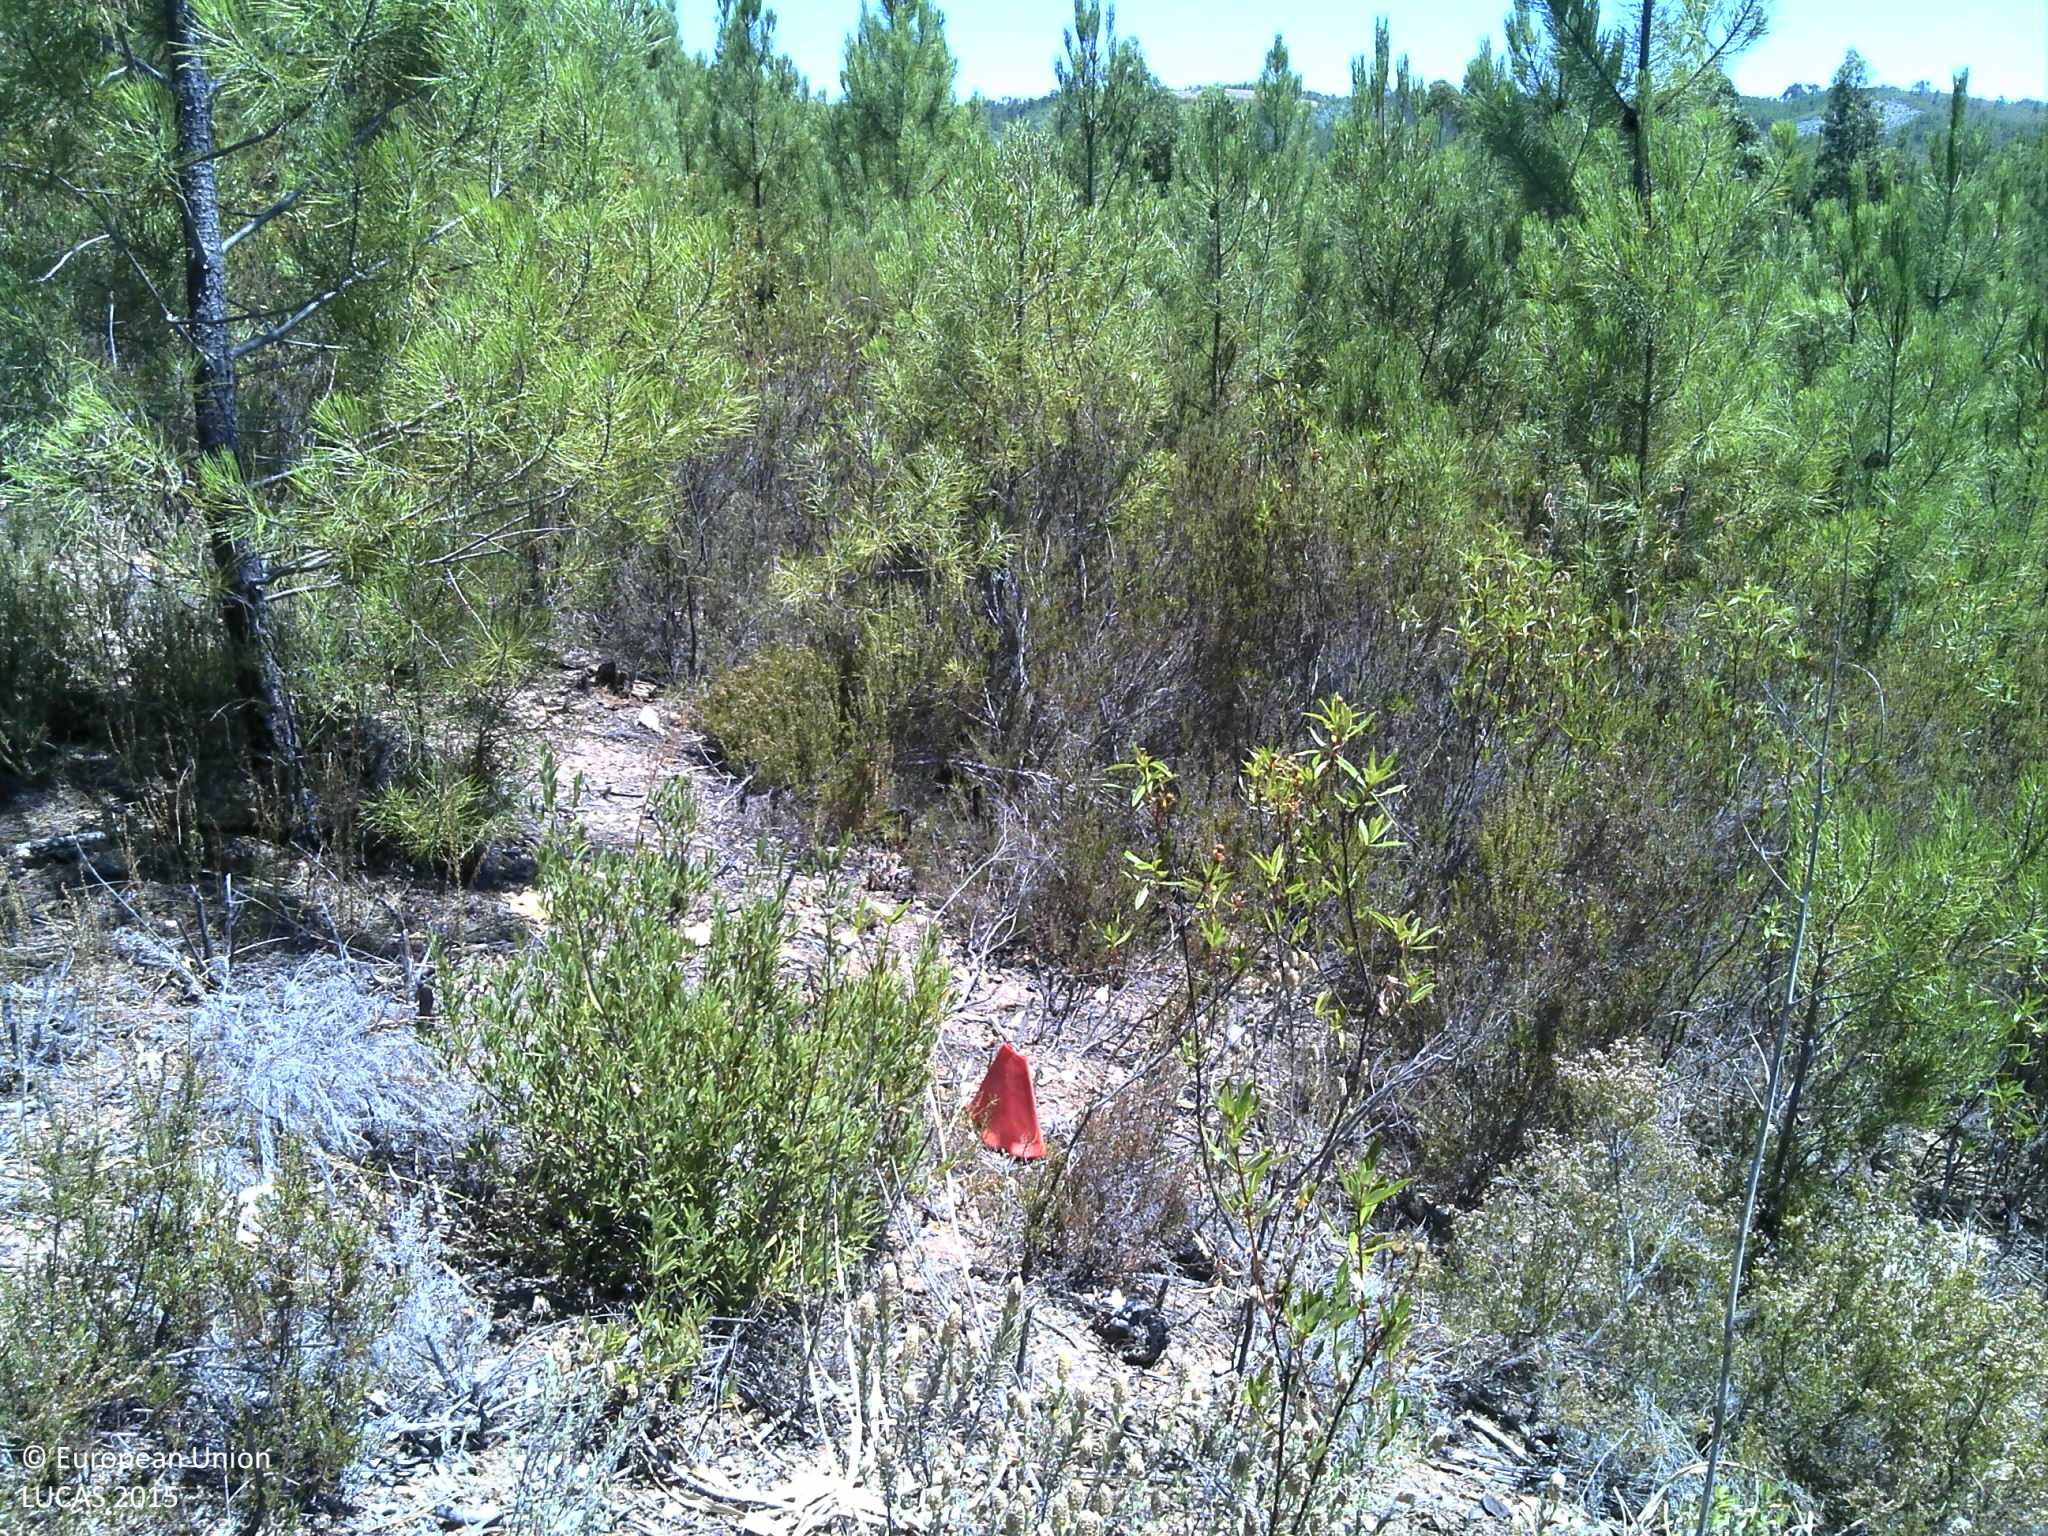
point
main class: Woodland
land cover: Pine dominated coniferous woodland
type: coniferous forest of the mediterranean region
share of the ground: 10 - 25 %
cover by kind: unconsolidated bare surface 40 %, shrubs 30 %, coniferous forest trees 20 %, consolidated bare surface 10 %
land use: Forestry
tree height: < 5 m
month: July
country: PT
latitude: 39.7623
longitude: -7.7419
